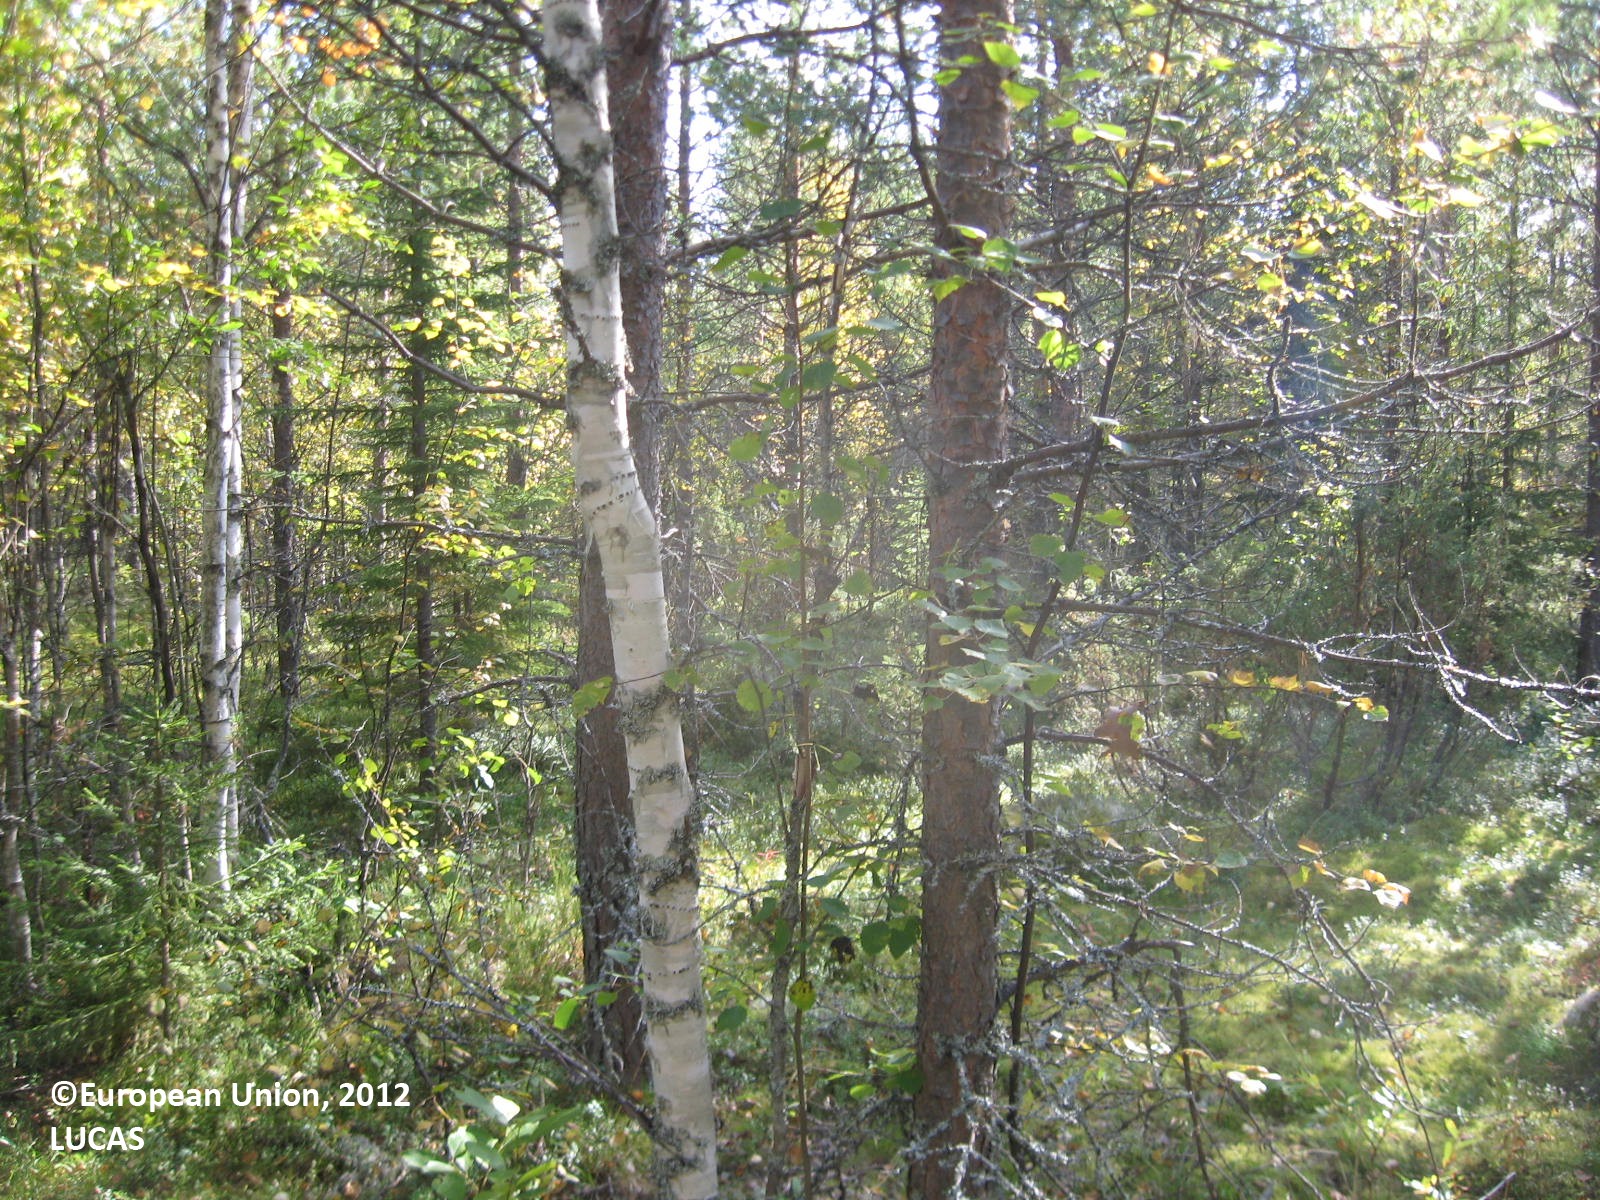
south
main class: Woodland
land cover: Other mixed woodland
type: boreal forest
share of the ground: > 75 %
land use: Forestry
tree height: > 5 m
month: August
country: FI
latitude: 63.8858
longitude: 28.7014
